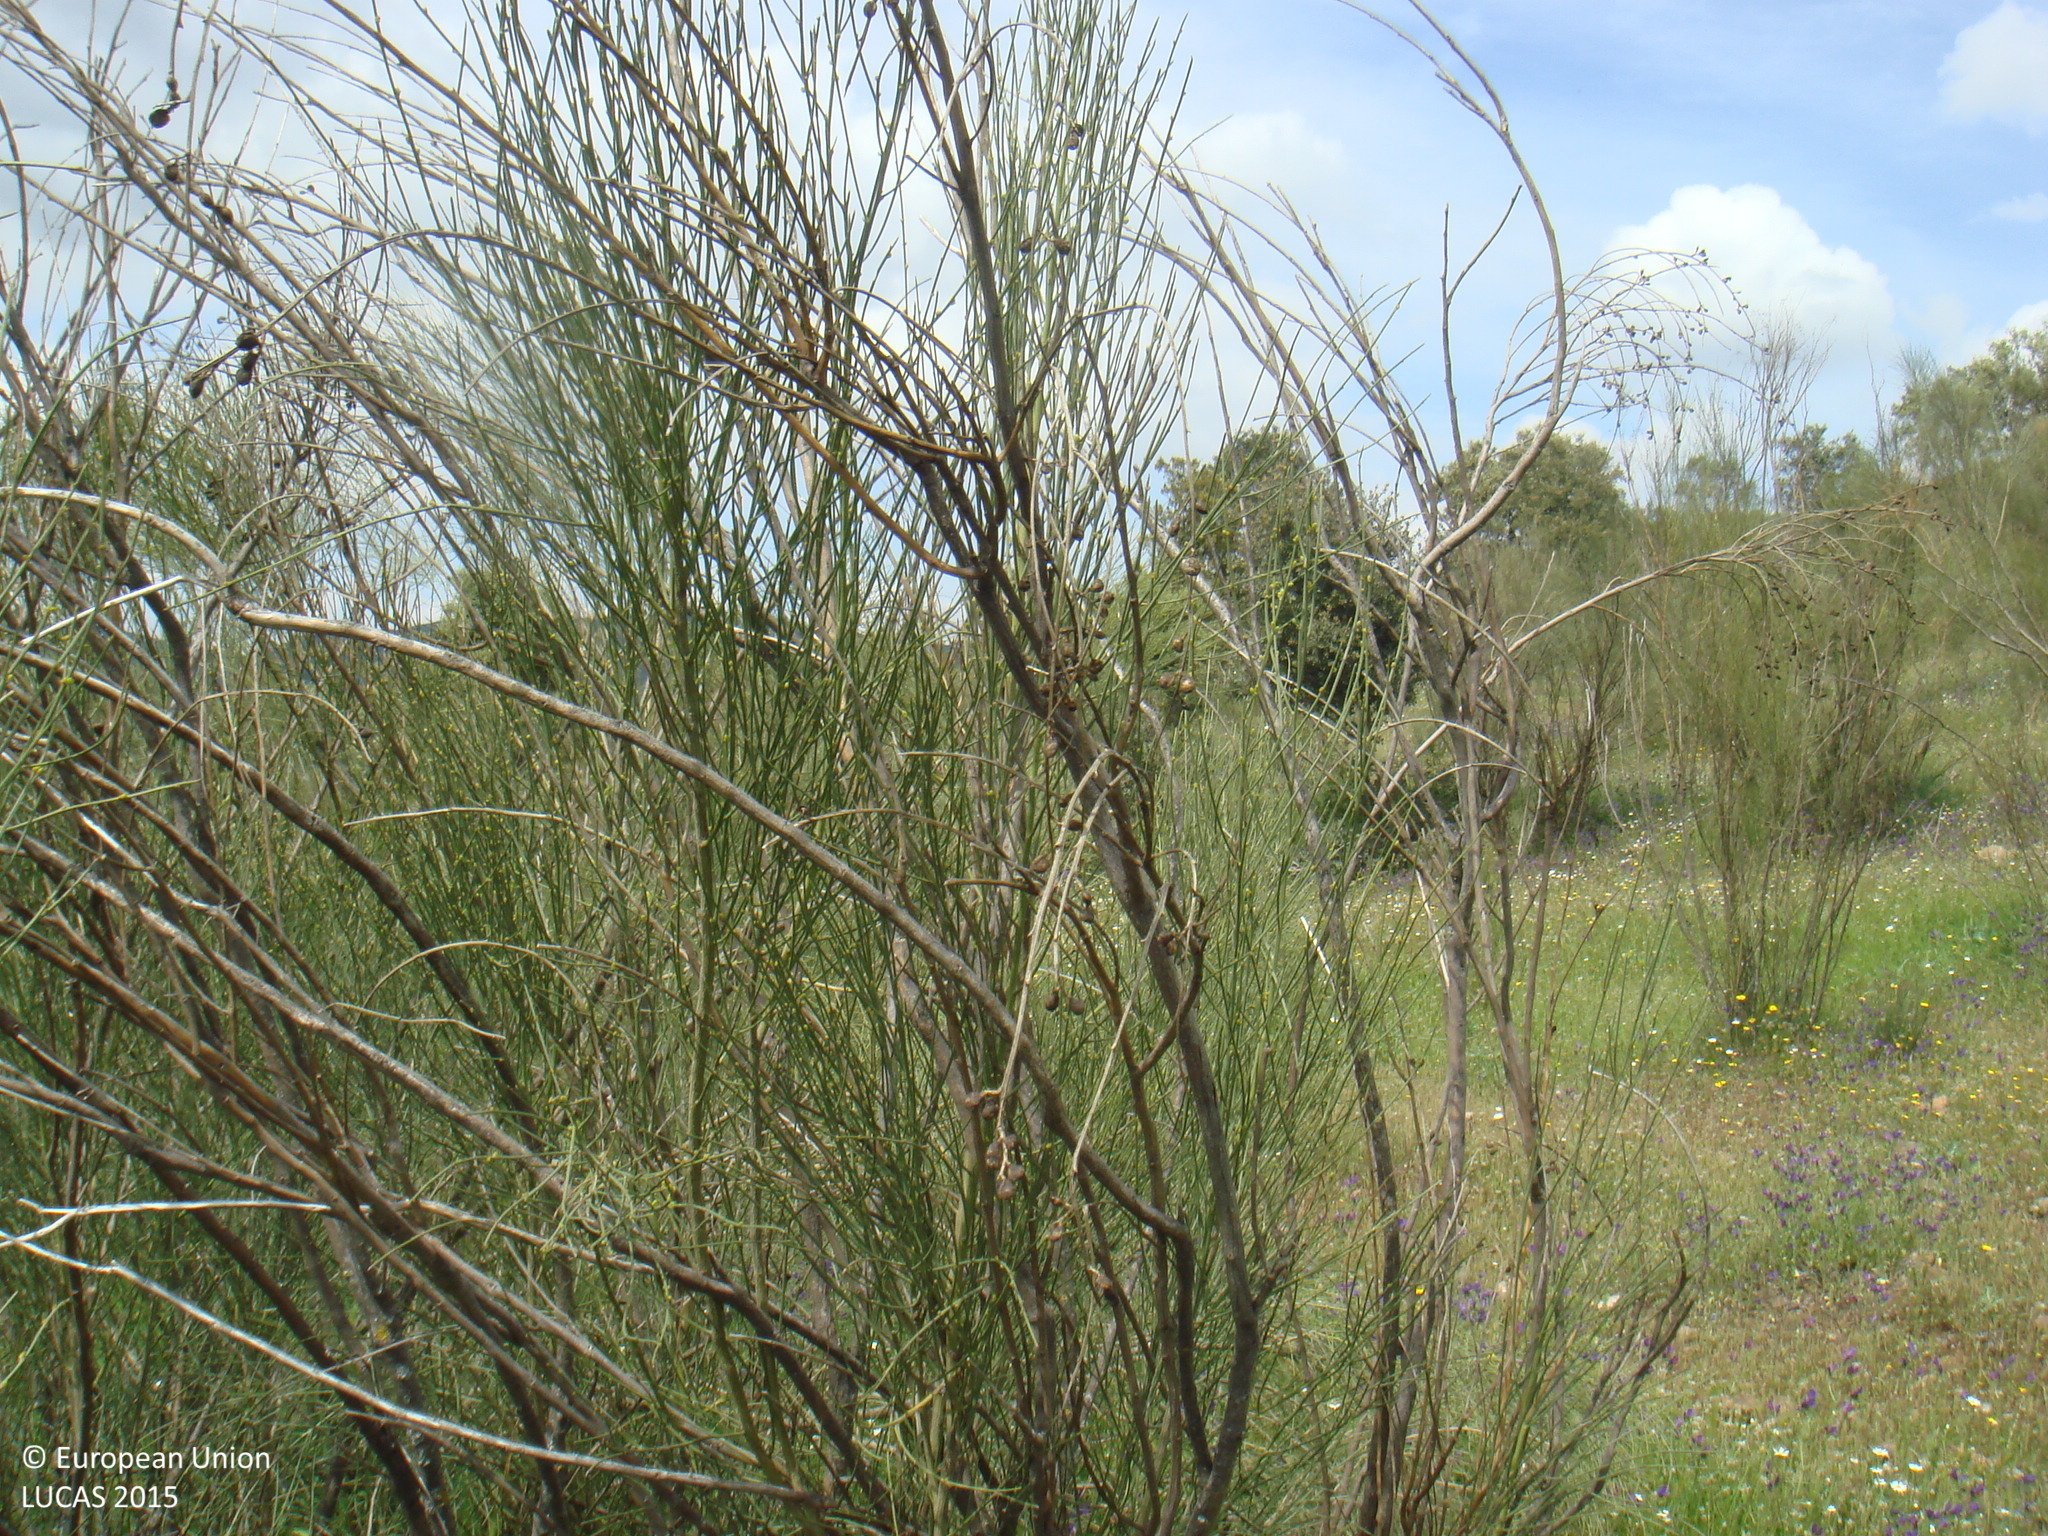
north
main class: Shrubland
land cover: Shrubland with sparse tree cover
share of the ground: 25 - 50 %
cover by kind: herbaceous plants 55 %, shrubs 40 %, broadleaved forest trees 5 %
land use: Semi-natural and natural areas not in use
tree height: > 5 m
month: April
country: ES
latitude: 38.2178
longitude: -5.0434
